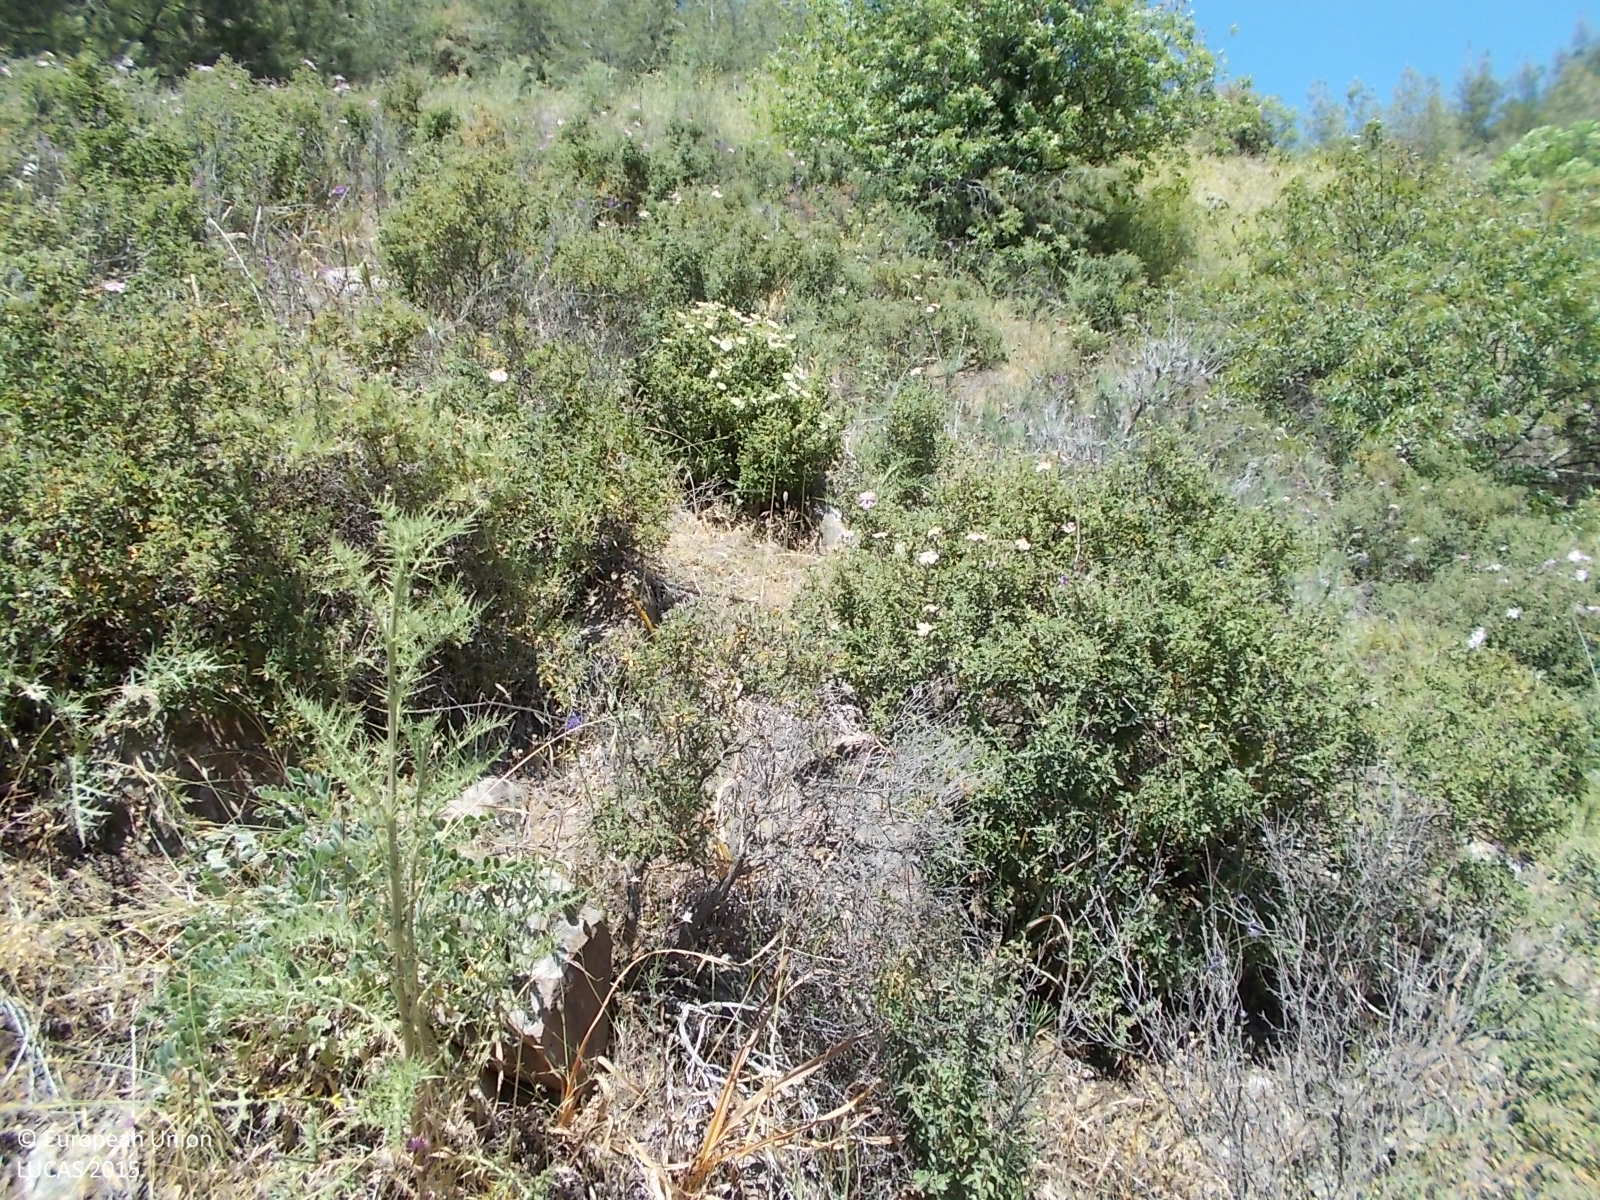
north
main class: Shrubland
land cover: Shrubland with sparse tree cover
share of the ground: > 75 %
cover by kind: shrubs 75 %, unconsolidated bare surface 20 %, coniferous forest trees 5 %
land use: Semi-natural and natural areas not in use
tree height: > 5 m
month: May
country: CY
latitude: 34.9524
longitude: 33.1865
